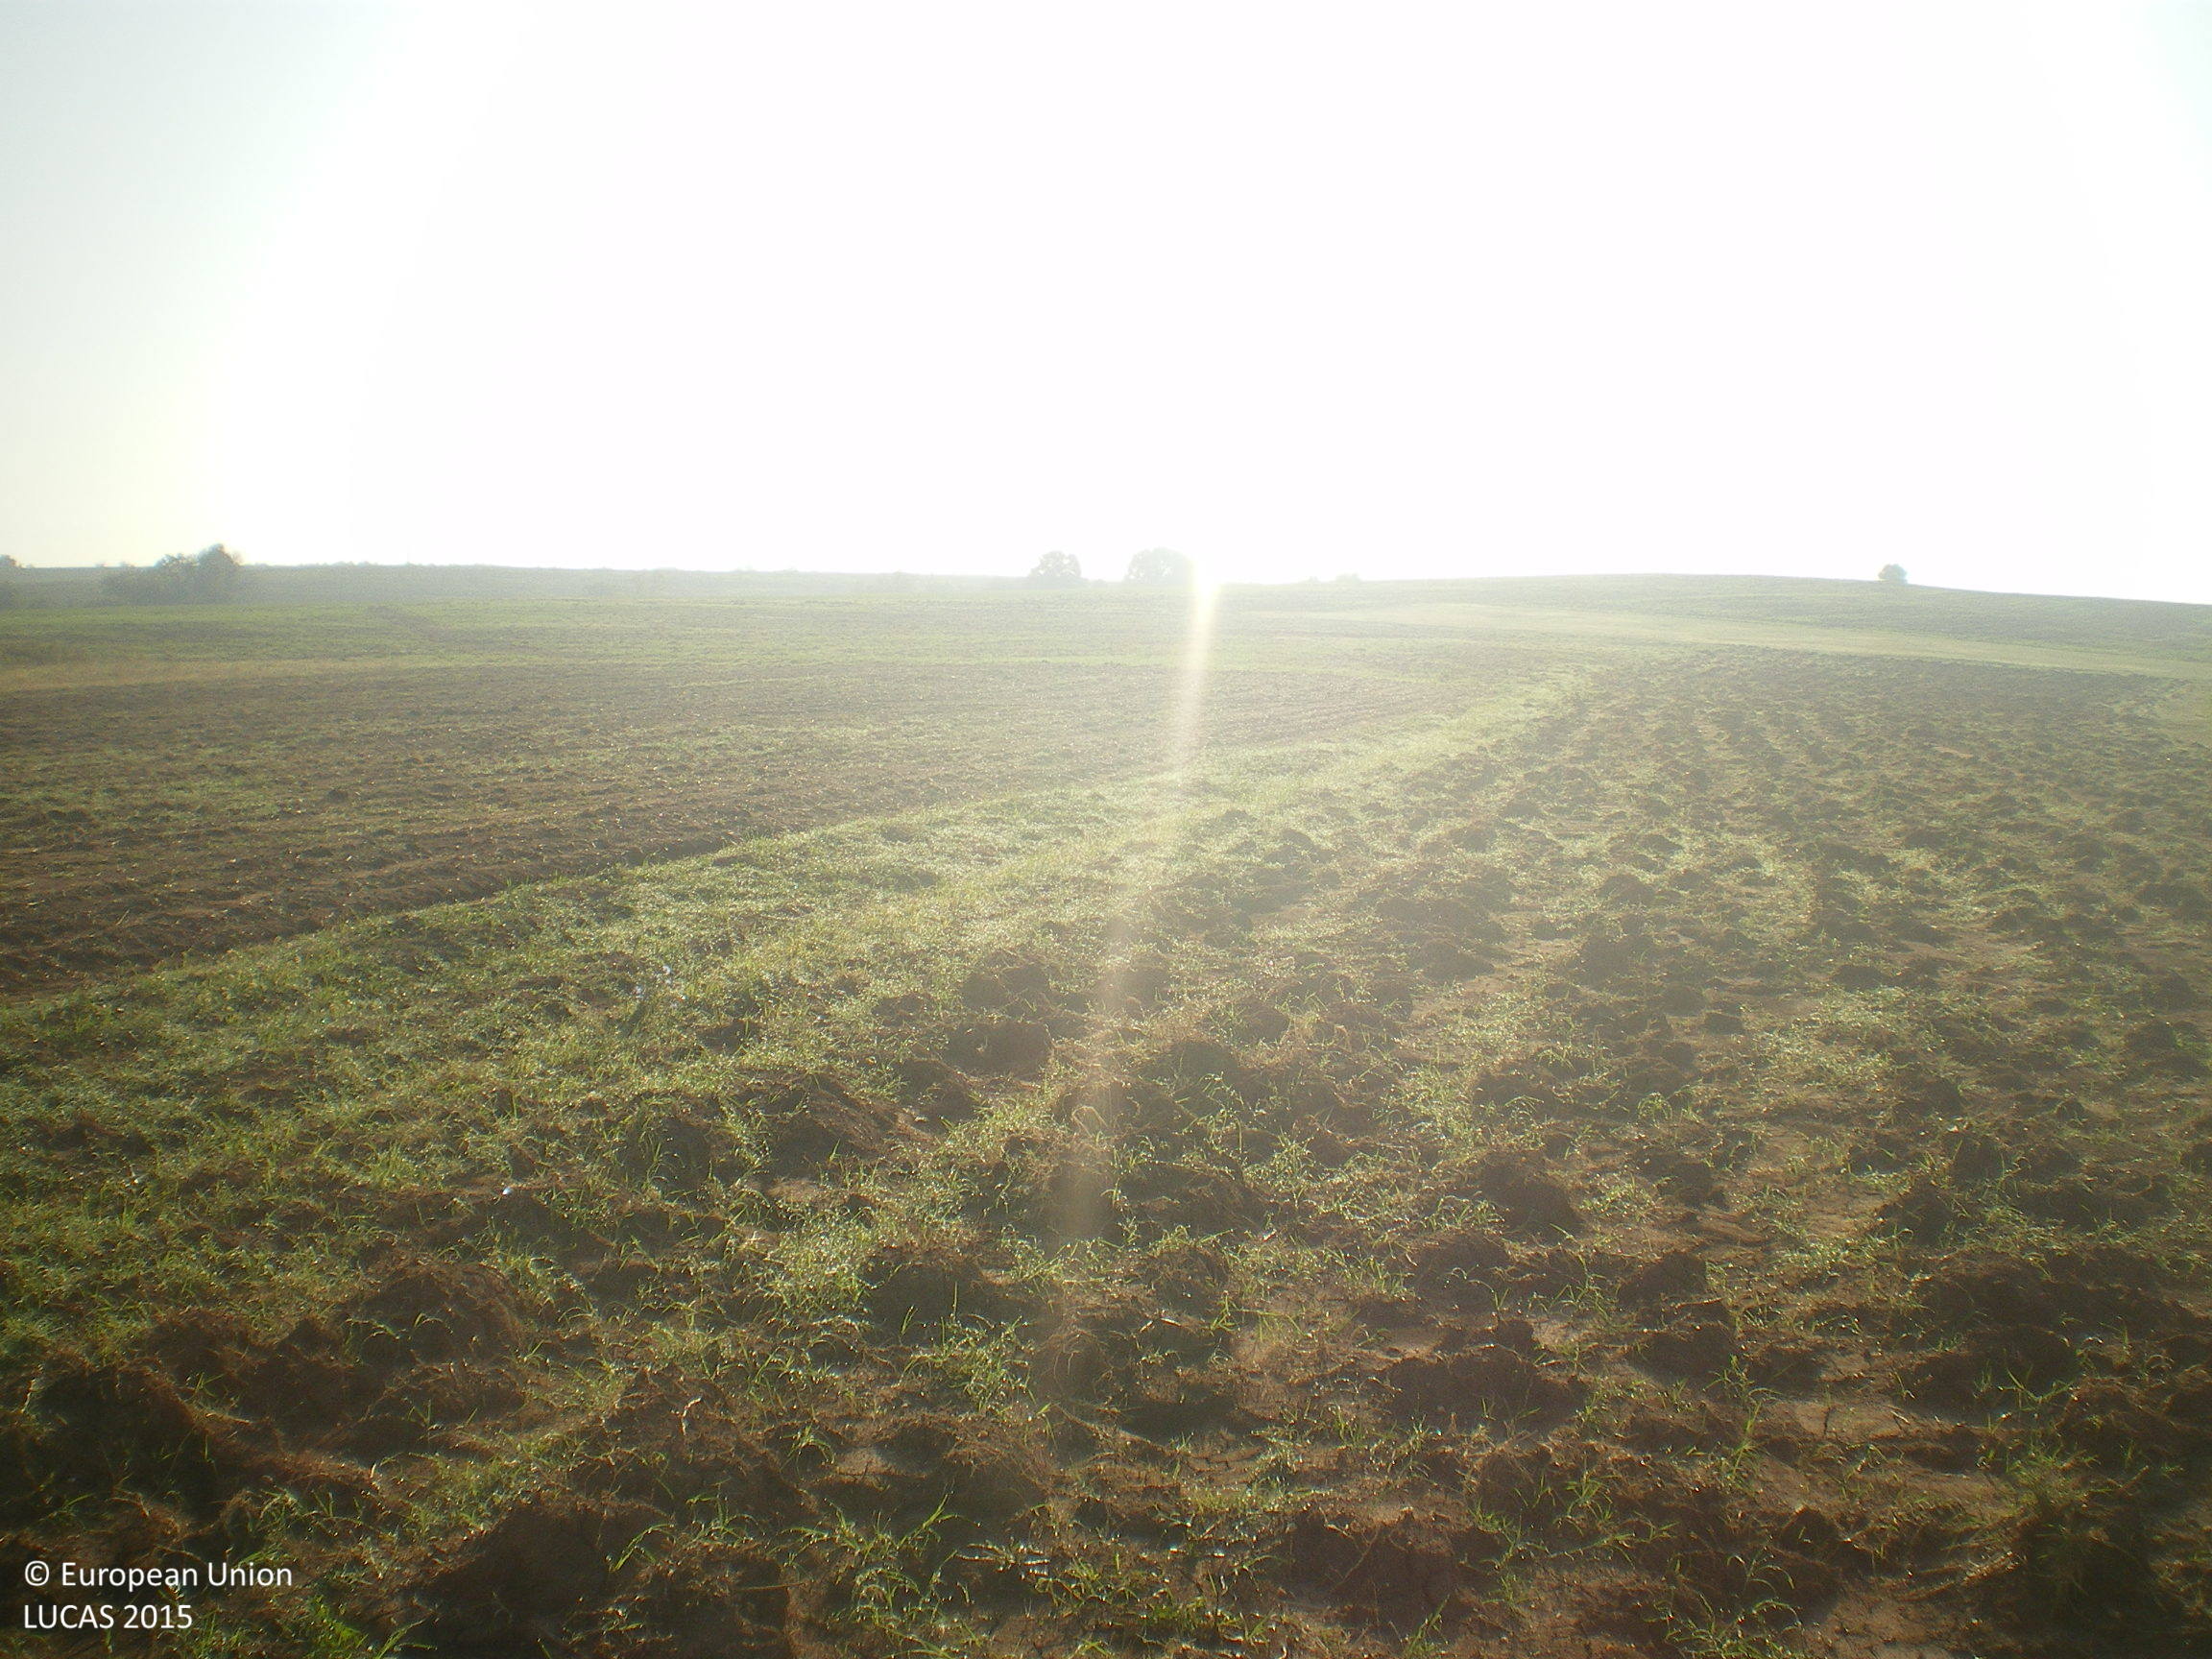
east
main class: Cropland
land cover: Common wheat
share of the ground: < 10 %
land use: Agriculture (excluding fallow land and kitchen gardens)
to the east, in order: Common wheat; Spontaneously vegetated surfaces; Tracks; Grass margins; Lucerne
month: September
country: BG
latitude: 41.8152
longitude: 25.8753
